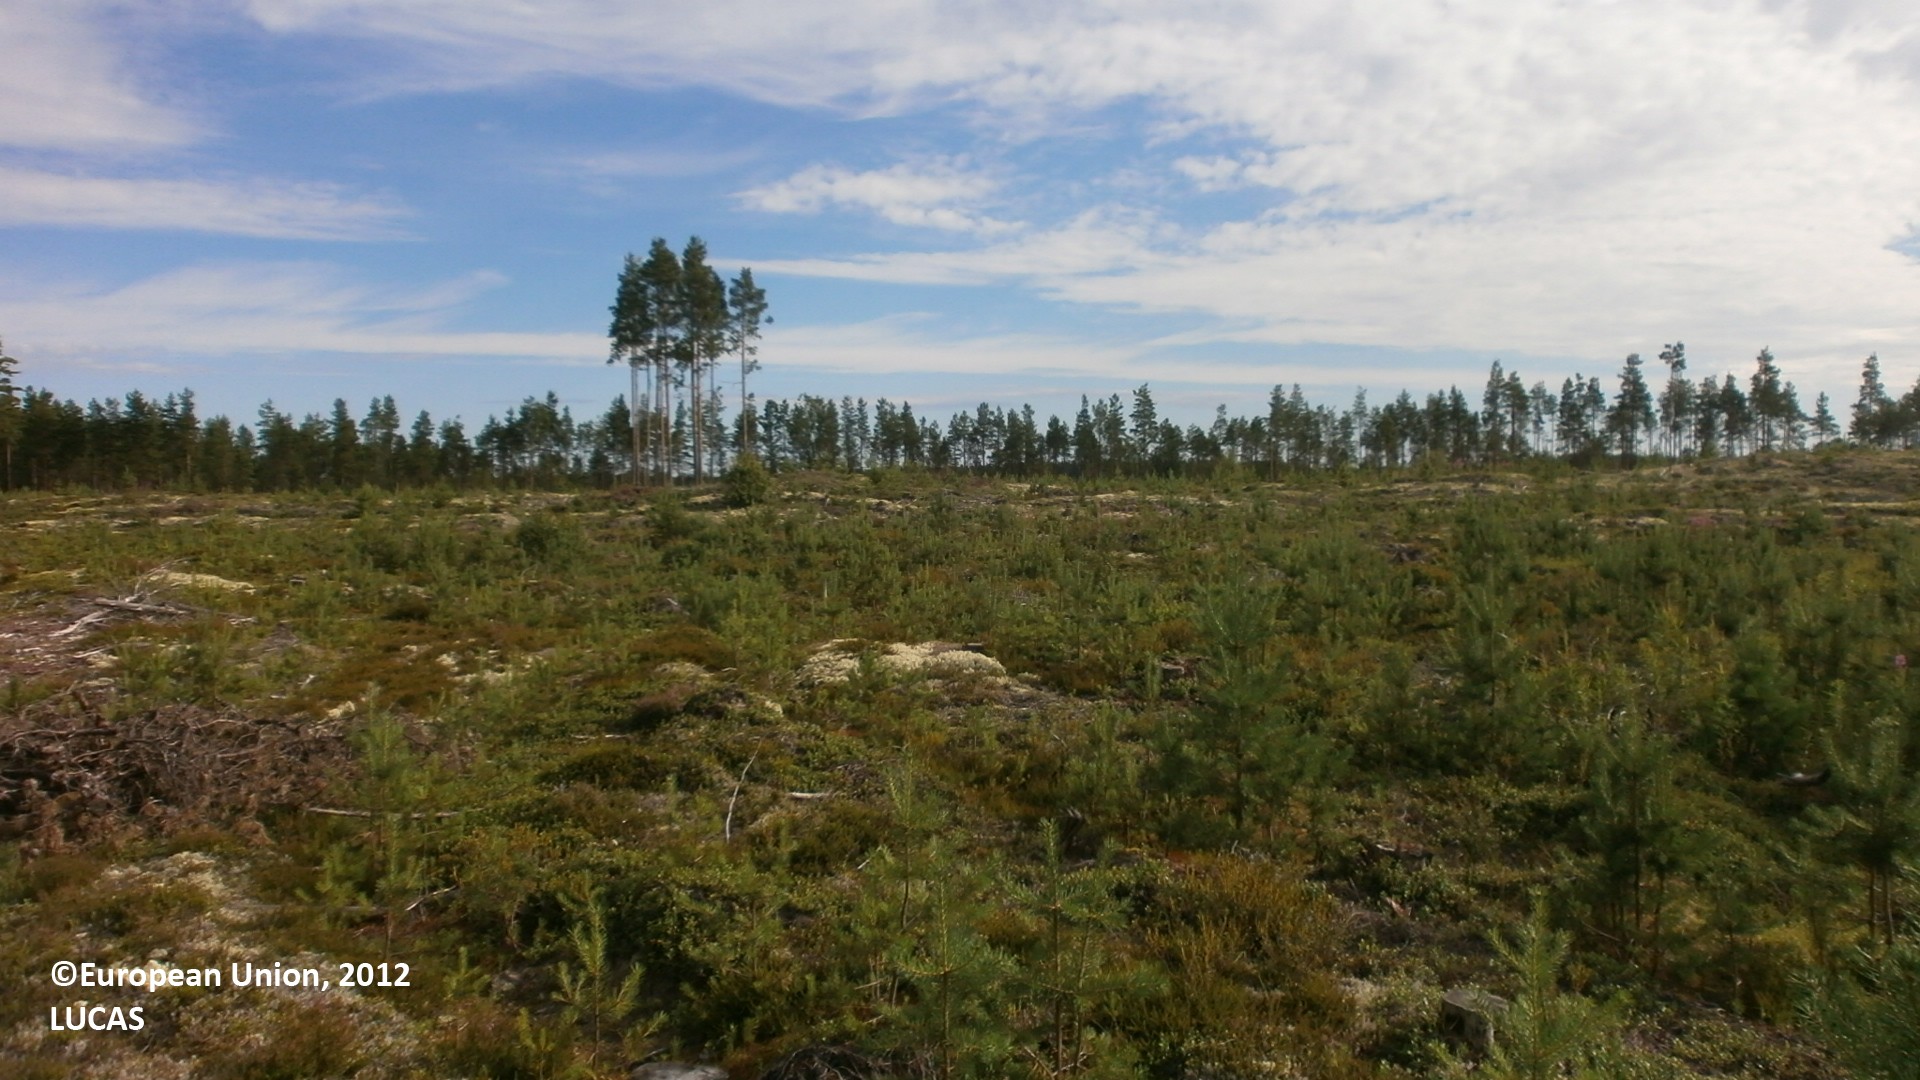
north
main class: Woodland
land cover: Pine dominated coniferous woodland
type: boreal forest
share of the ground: 10 - 25 %
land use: Forestry
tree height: < 5 m
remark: Clear cut
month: July
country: FI
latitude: 64.0837
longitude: 24.0304
